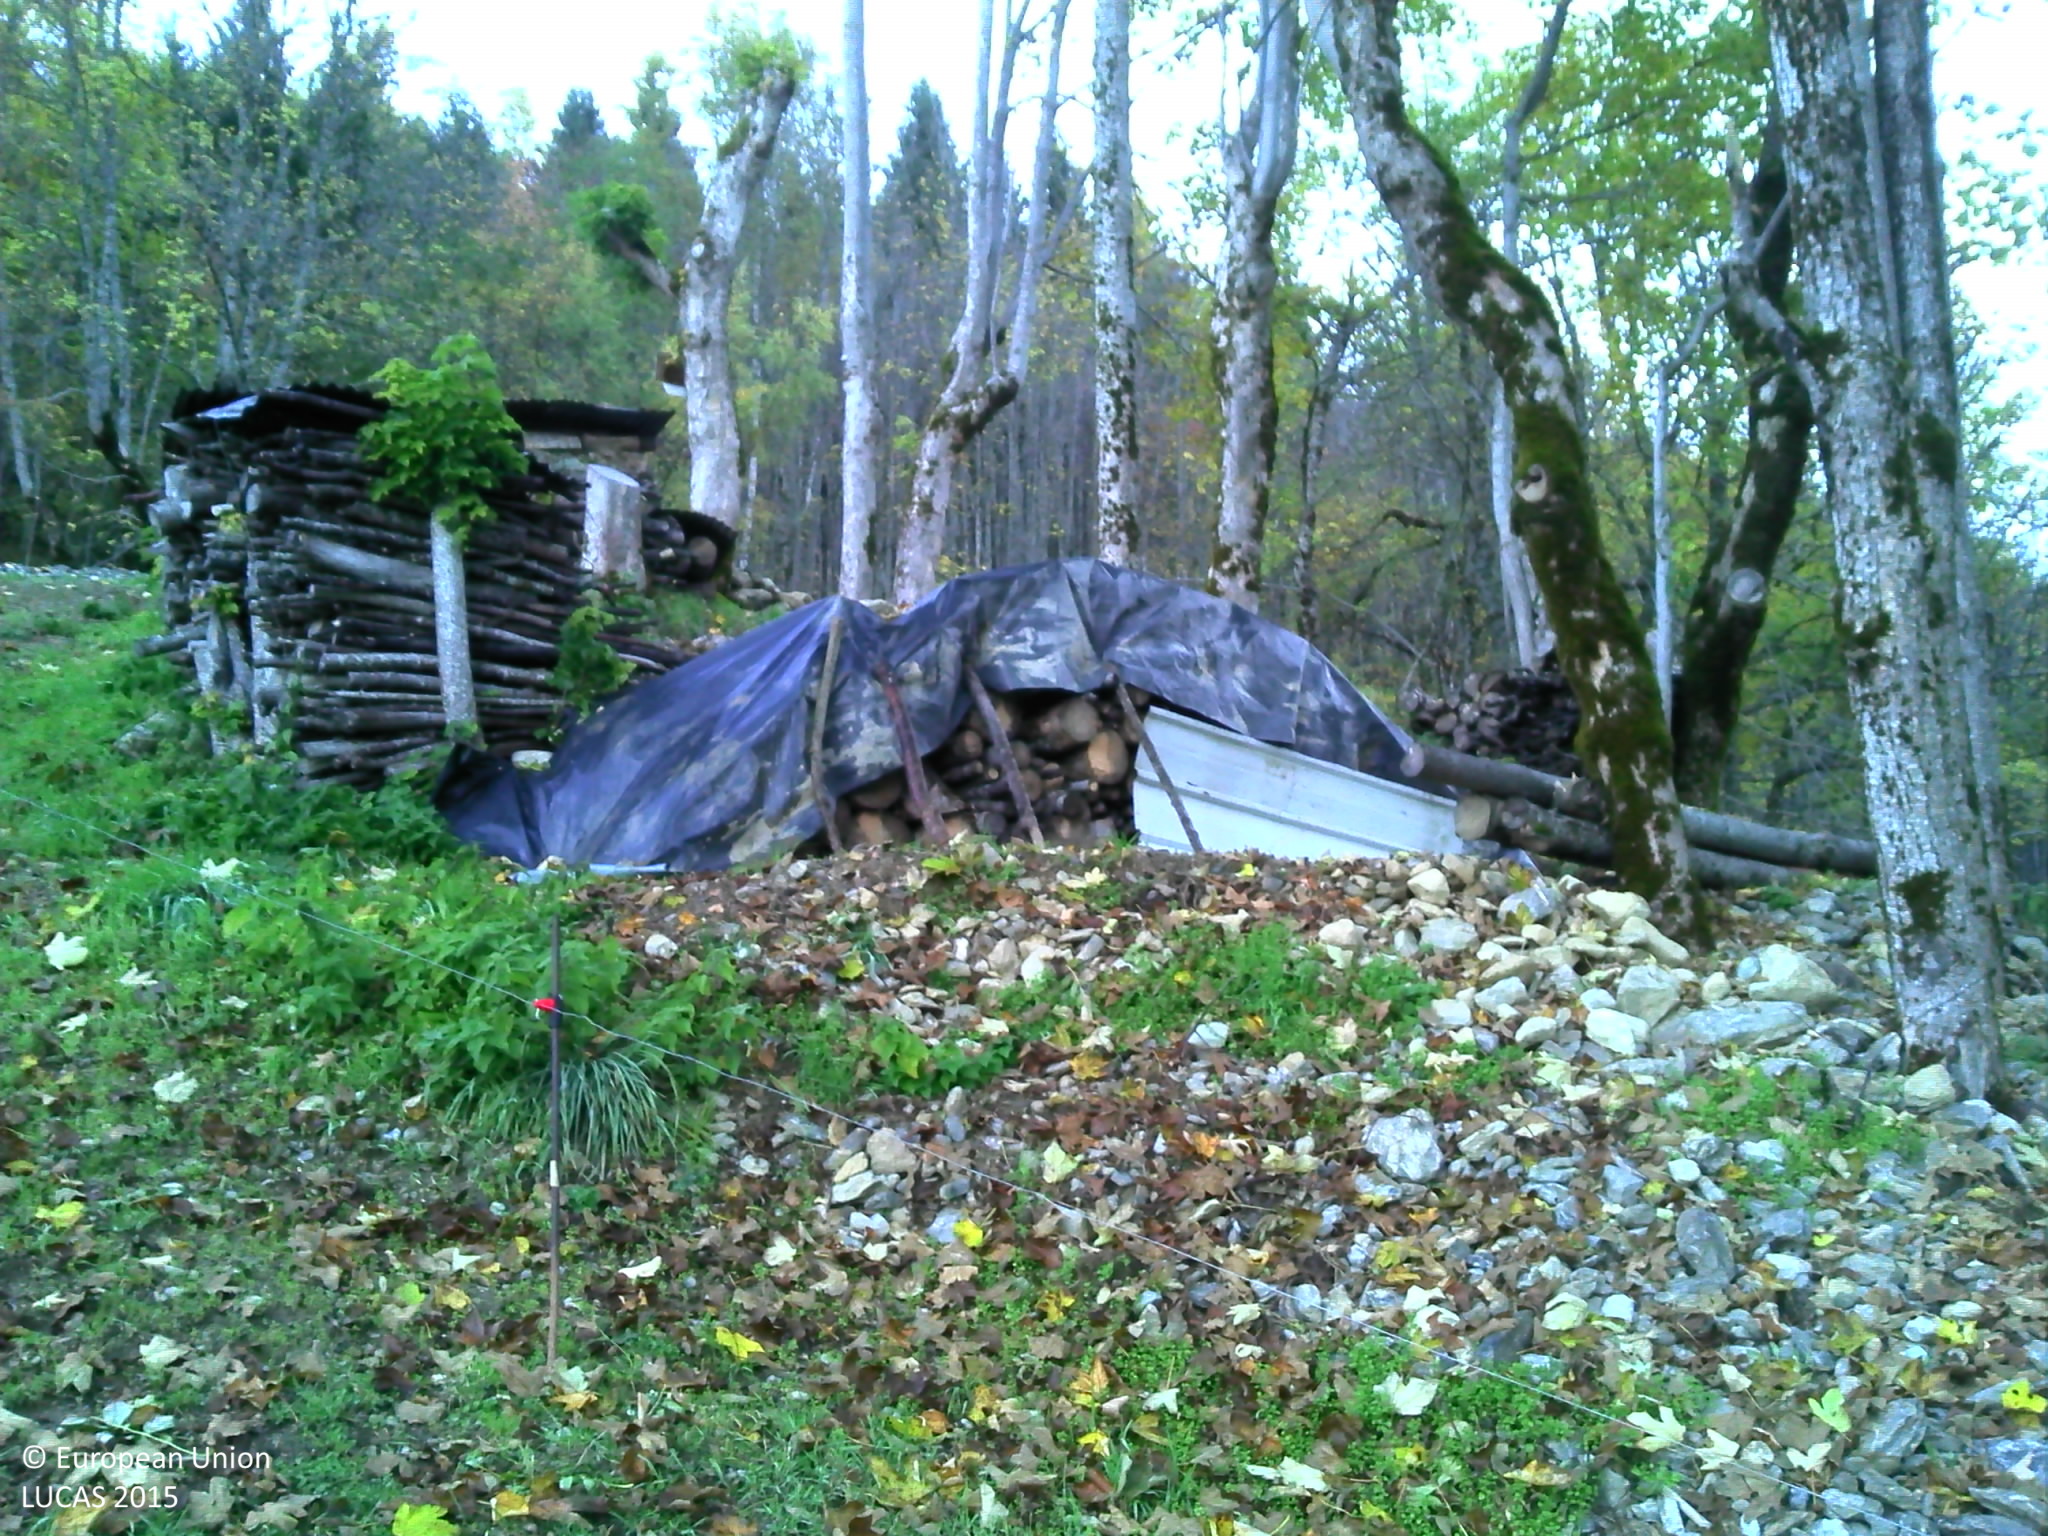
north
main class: Grassland
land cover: Grassland without tree/shrub cover
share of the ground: > 75 %
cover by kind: herbaceous plants 95 %, unconsolidated bare surface 5 %
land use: Agriculture (excluding fallow land and kitchen gardens)
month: October
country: FR
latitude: 45.5317
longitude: 6.3552
